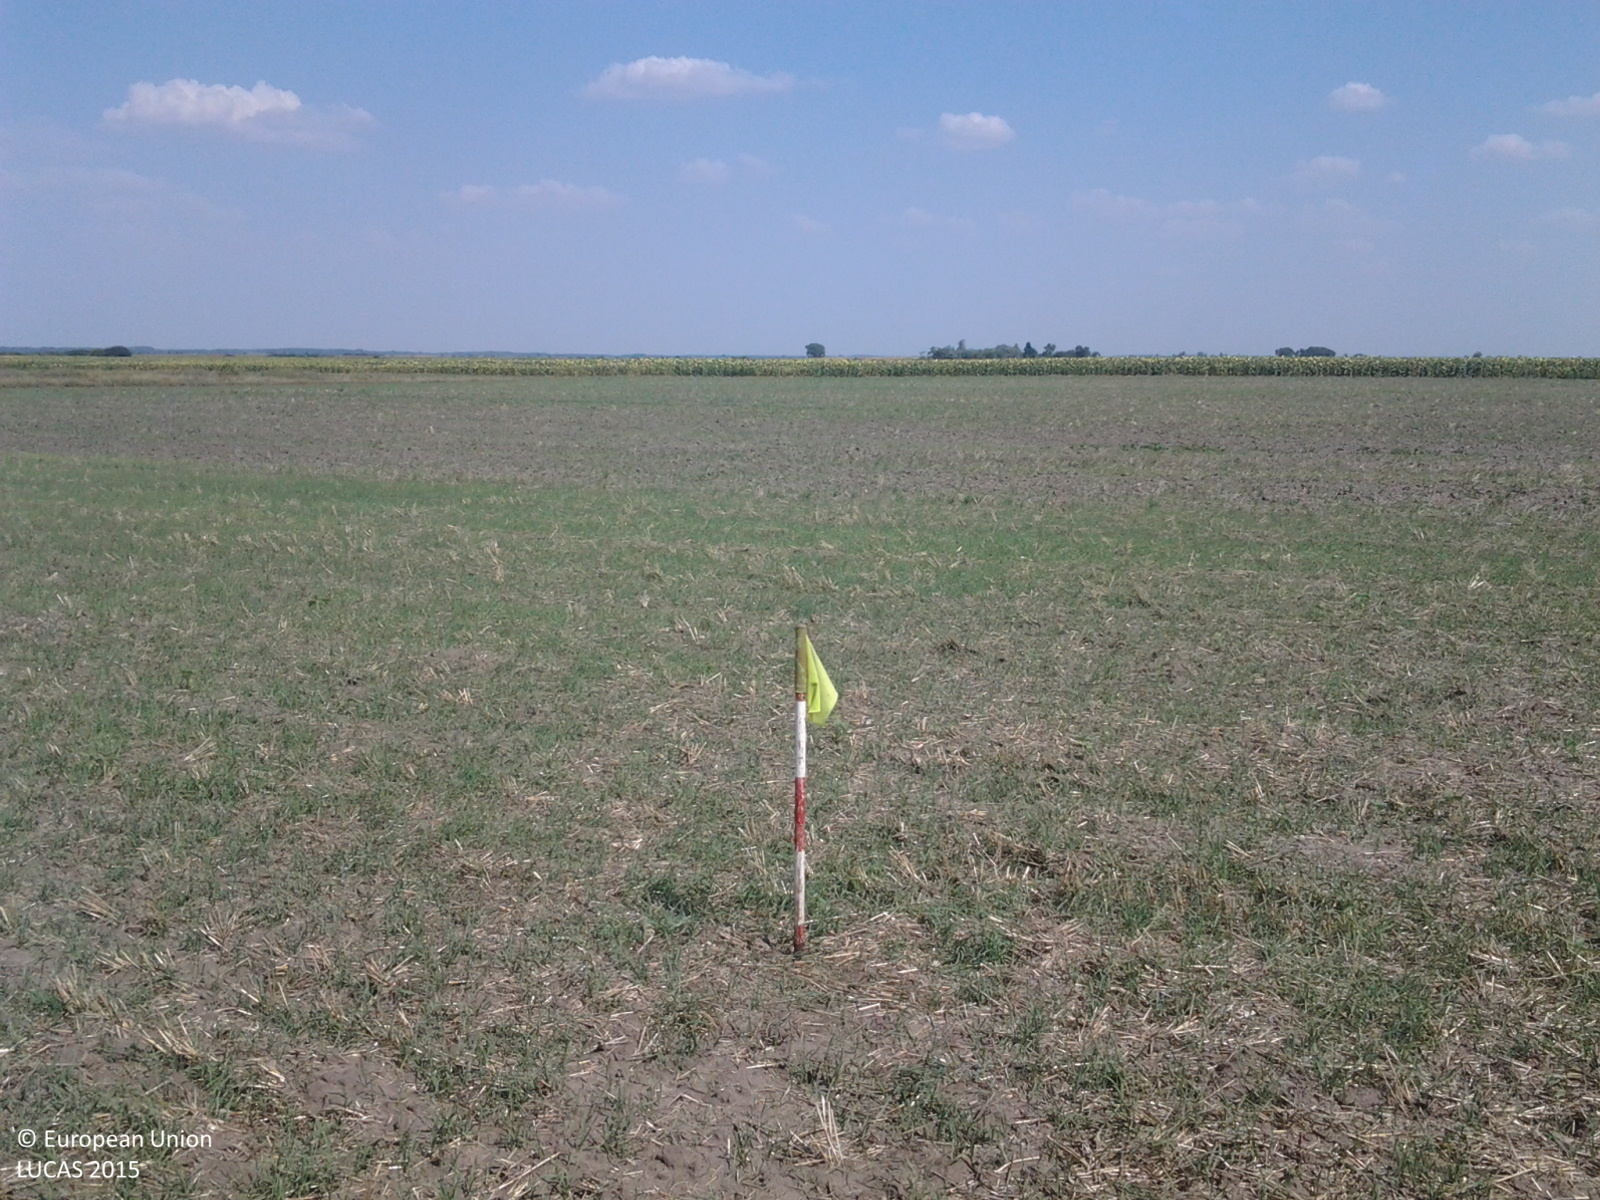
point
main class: Cropland
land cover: Common wheat
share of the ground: 10 - 25 %
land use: Agriculture (excluding fallow land and kitchen gardens)
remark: Harvested field
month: August
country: HU
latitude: 47.2861
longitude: 19.7140
